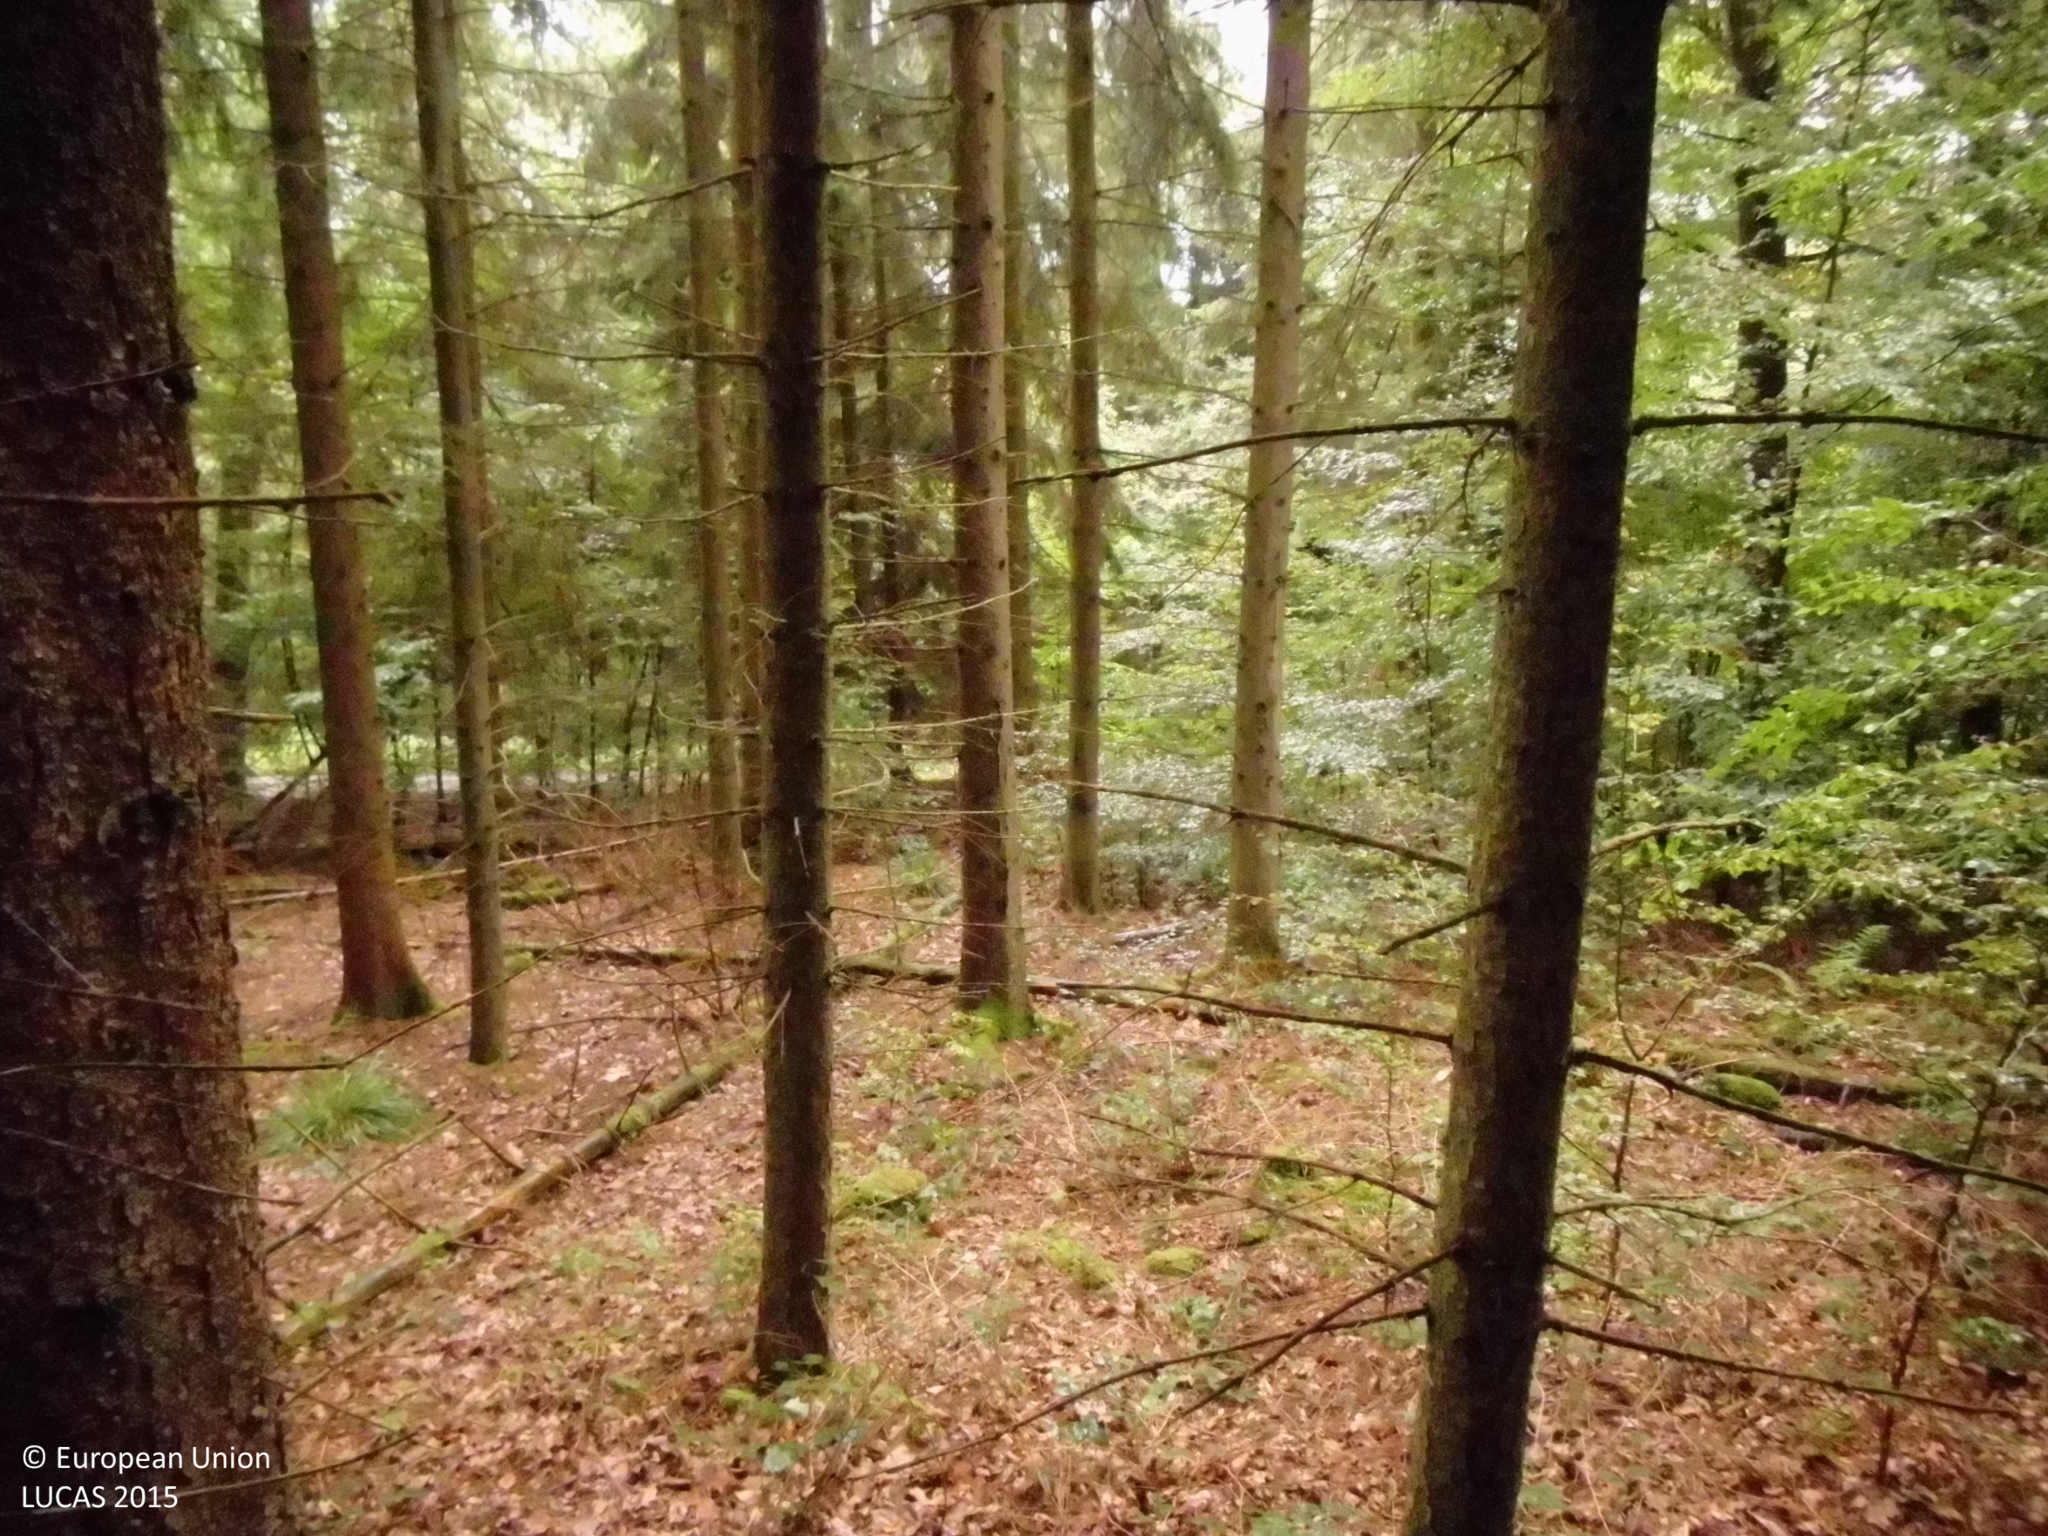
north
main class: Woodland
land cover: Broadleaved woodland
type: mesophytic deciduous forest
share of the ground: > 75 %
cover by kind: broadleaved forest trees 100 %
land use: Forestry
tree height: > 5 m
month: September
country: DE
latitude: 50.6239
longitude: 7.4700
